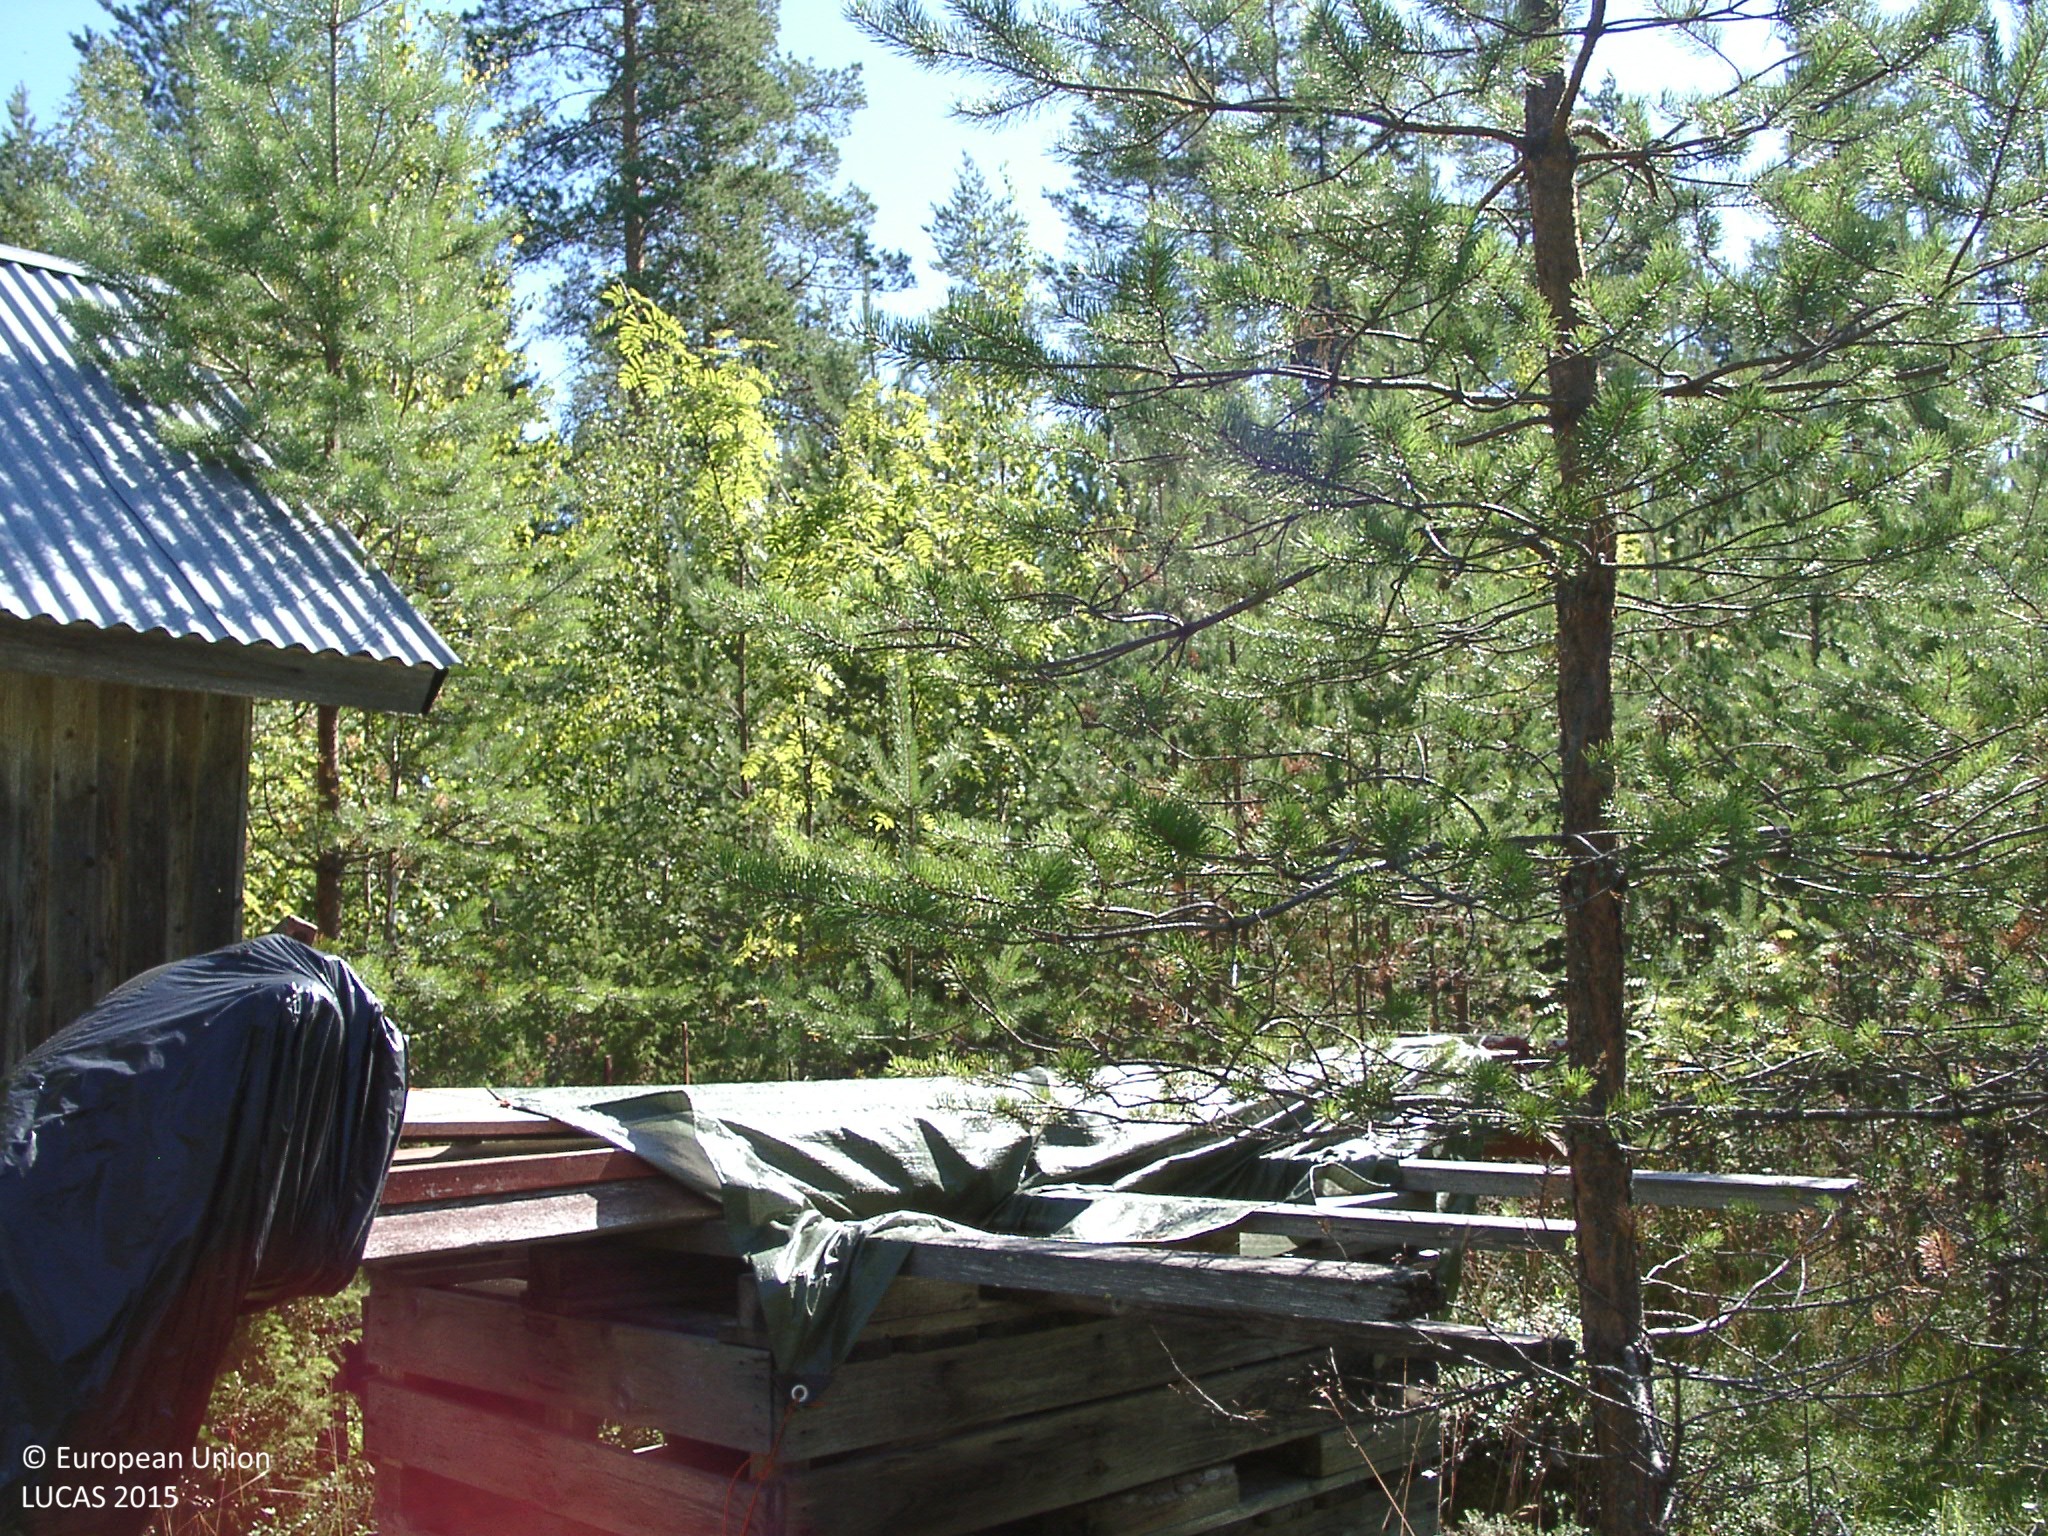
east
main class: Woodland
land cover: Pine dominated mixed woodland
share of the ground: 25 - 50 %
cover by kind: shrubs 25 %, coniferous forest trees 20 %, broadleaved forest trees 10 %, herbaceous plants 10 %, lichens and mosses 5 %
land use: Residential
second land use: Forestry
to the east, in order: Pine dominated mixed woodland; Artificial constructions in urban areas; Other mixed woodland; Shrubland with sparse tree cover; Pine dominated mixed woodland; Tracks; Pine dominated mixed woodland; Broadleaved woodland; Other mixed woodland; Other bare soil
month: August
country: FI
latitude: 62.4735
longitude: 25.2540
